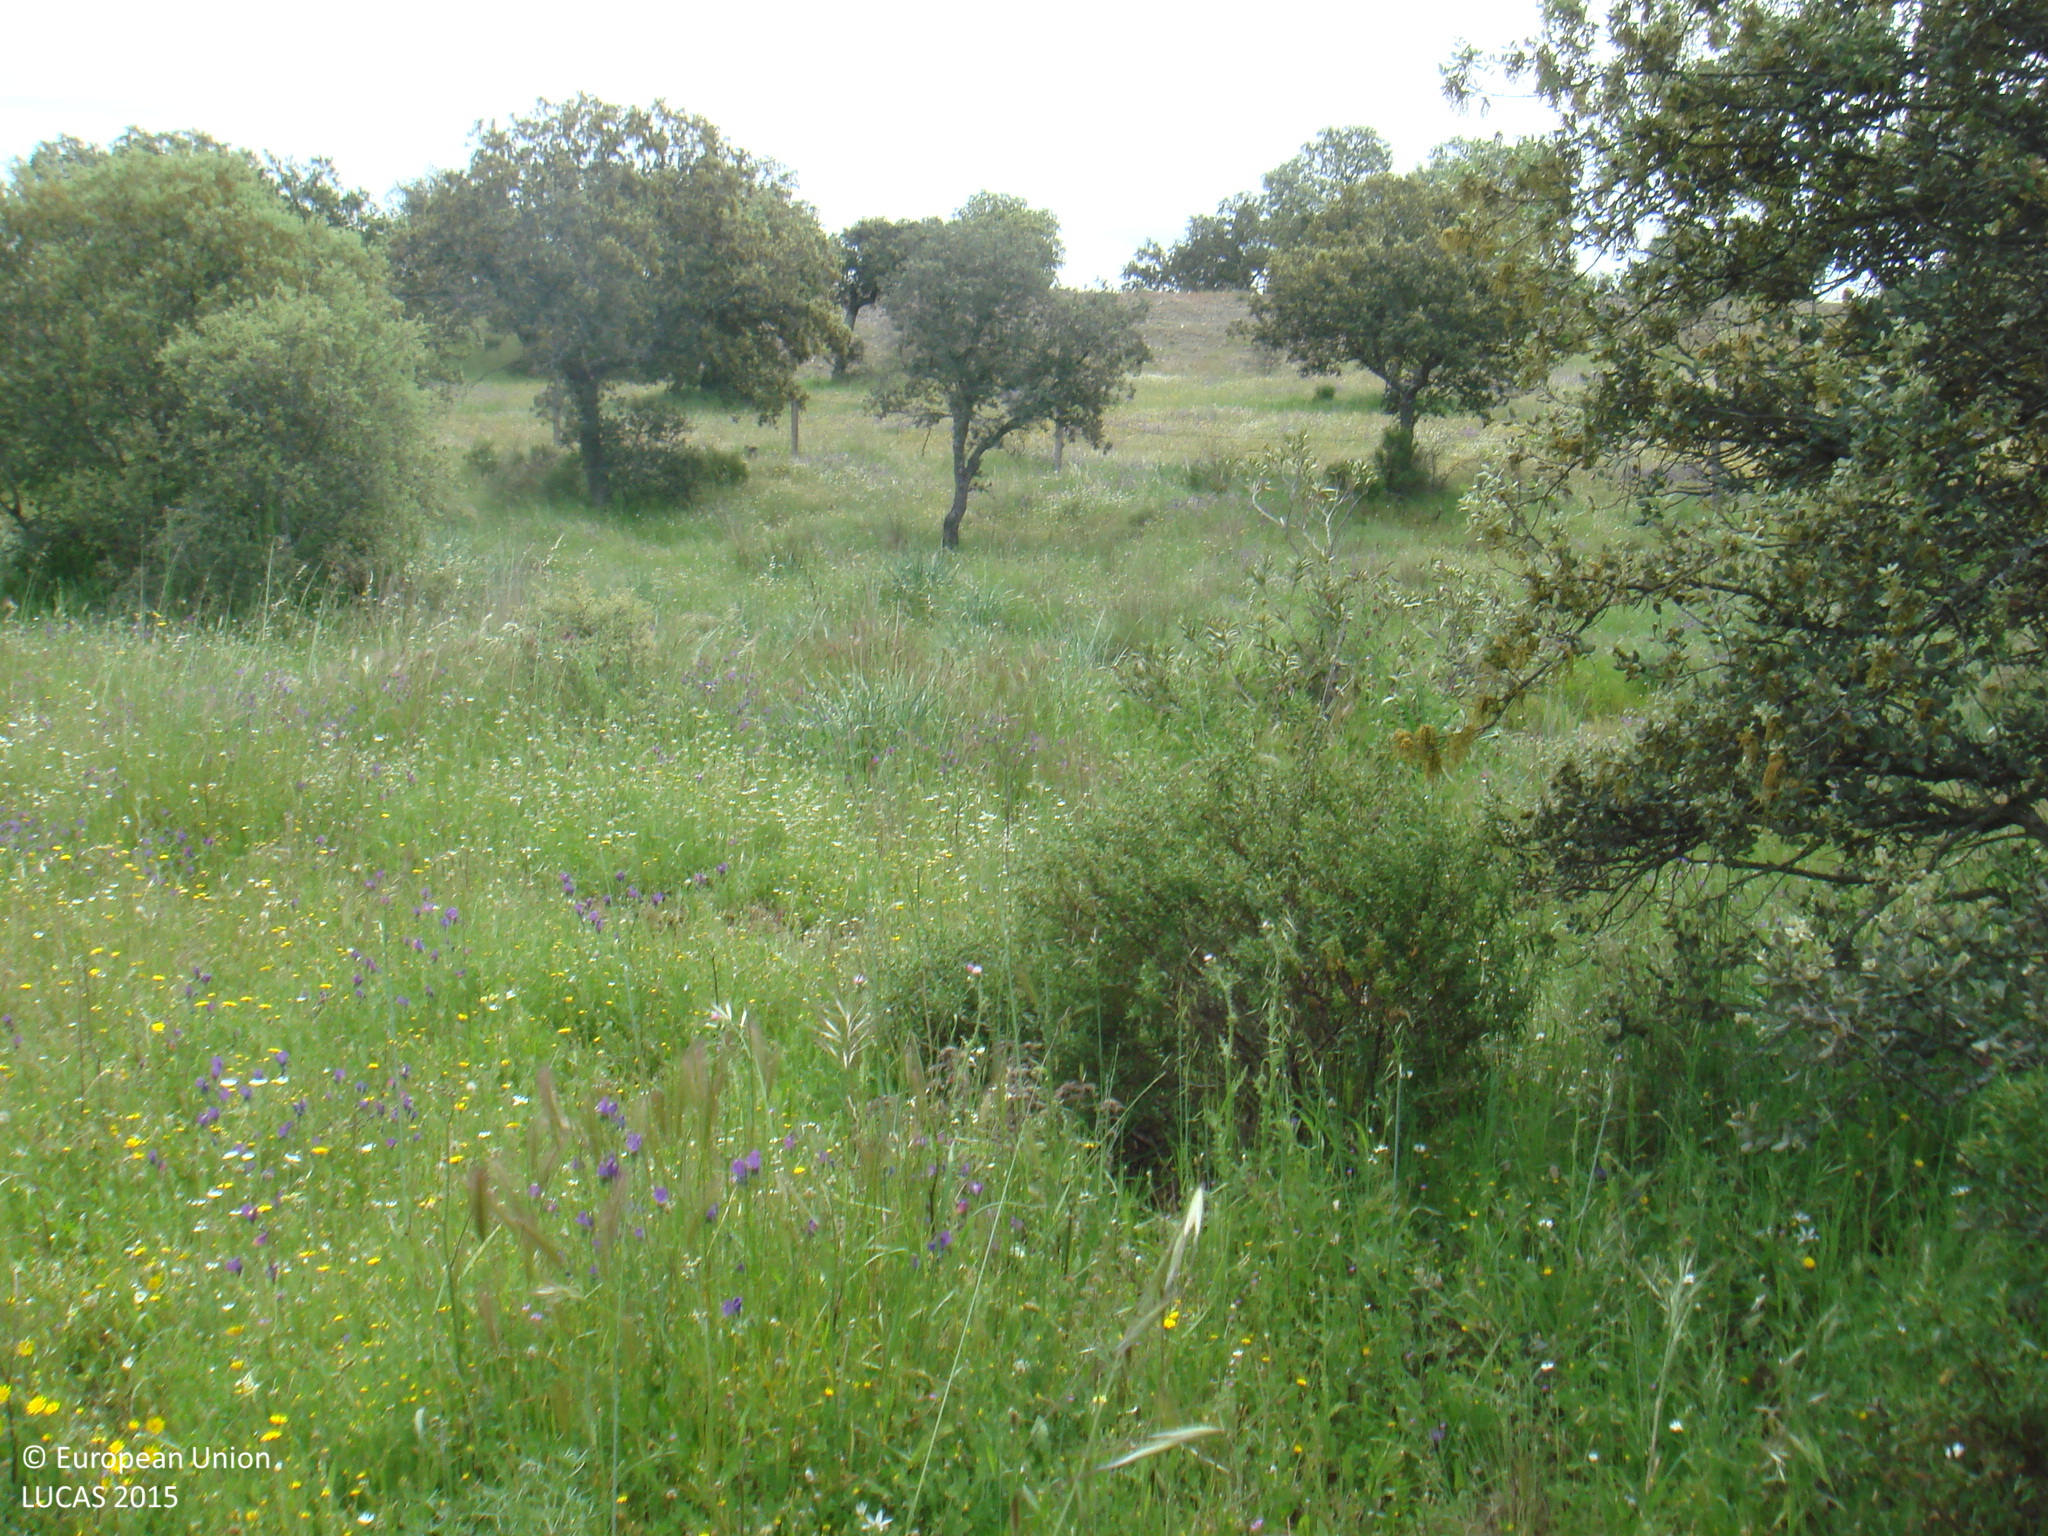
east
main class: Woodland
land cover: Broadleaved woodland
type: broadleaved evergreen forest
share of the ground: 10 - 25 %
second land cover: Grassland without tree/shrub cover
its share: > 75 %
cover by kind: herbaceous plants 80 %, broadleaved forest trees 15 %, shrubs 5 %
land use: Forestry
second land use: Agriculture (excluding fallow land and kitchen gardens)
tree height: > 5 m
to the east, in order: Broadleaved woodland; Grassland without tree/shrub cover; Rivers and streams; Broadleaved woodland; Fences; Grassland with sparse tree/shrub cover; Tracks; Broadleaved woodland; Rivers and streams; Broadleaved woodland
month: May
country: ES
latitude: 38.3420
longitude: -5.0715
